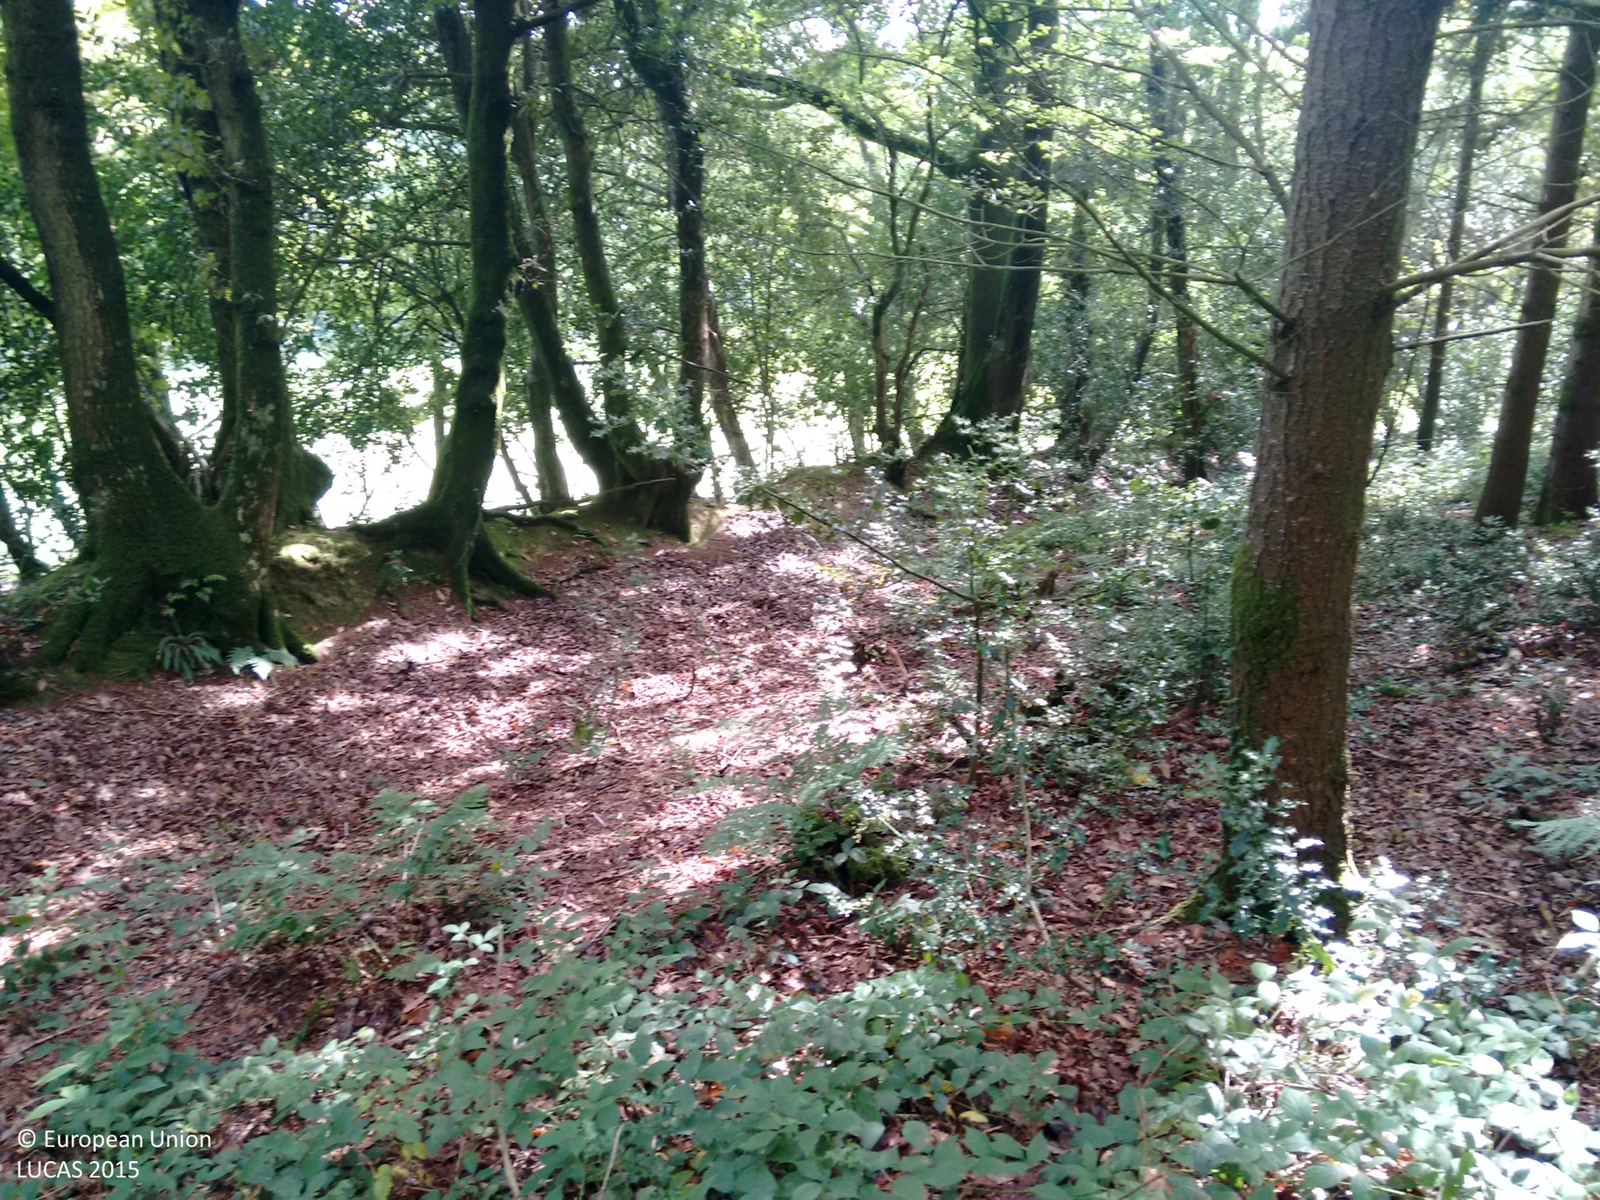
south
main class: Woodland
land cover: Spruce dominated mixed woodland
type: exotic forest
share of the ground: > 75 %
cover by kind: coniferous forest trees 60 %, broadleaved forest trees 40 %
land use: Forestry
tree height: > 5 m
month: September
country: GB
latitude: 50.7296
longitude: -4.3683
